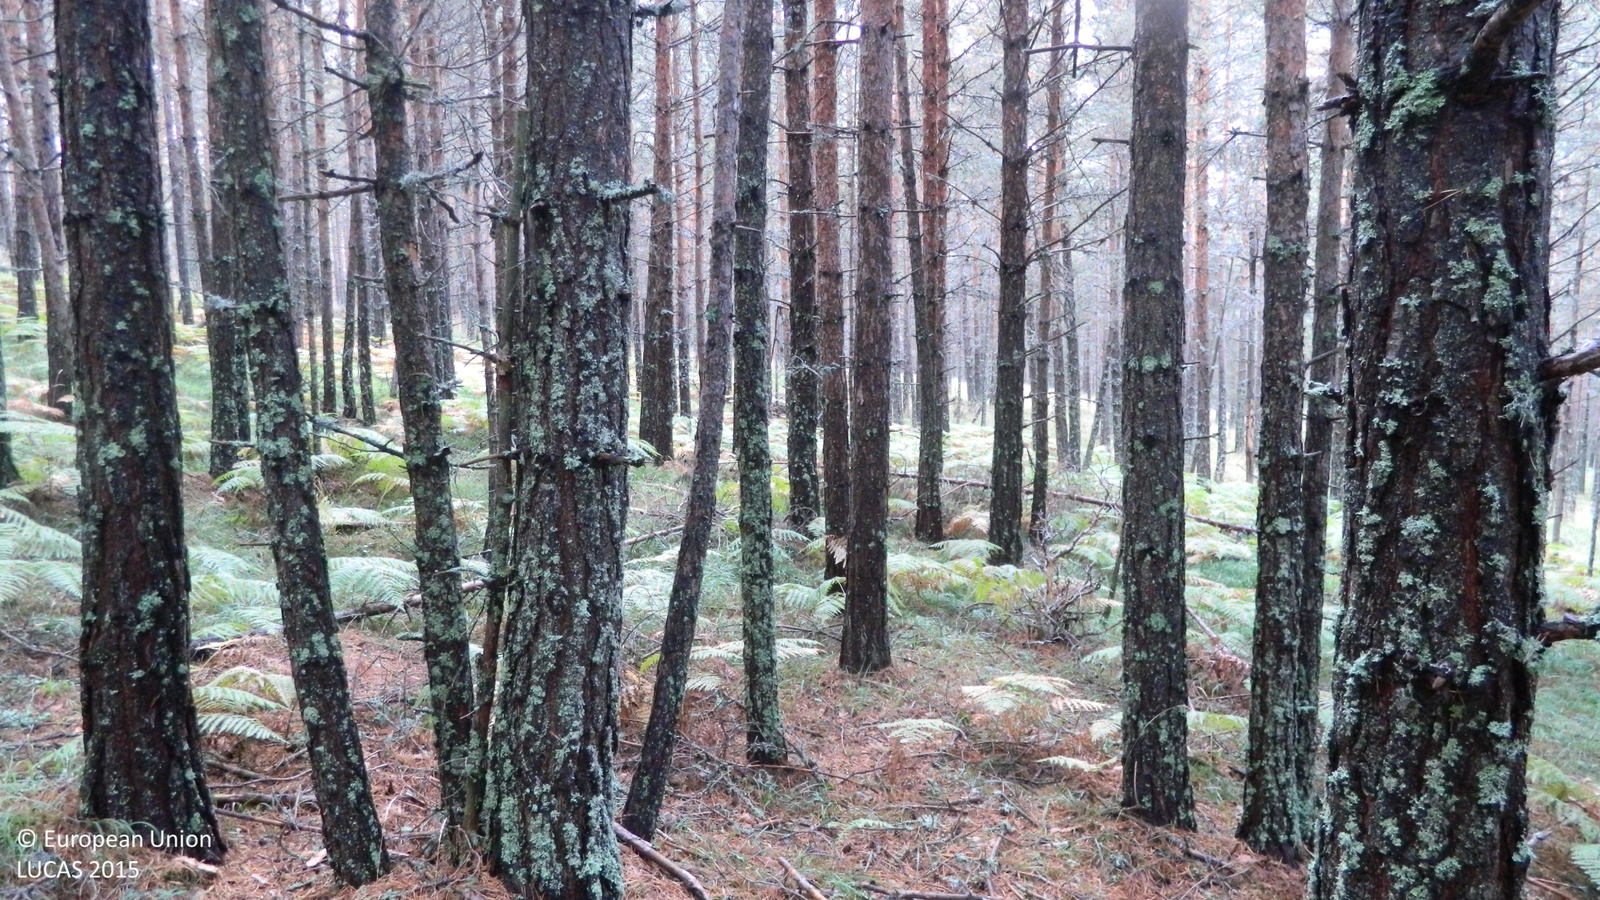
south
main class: Woodland
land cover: Pine dominated coniferous woodland
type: hemiboreal forest and nemoral coniferous forest and mixed broadleaved-coniferous forest
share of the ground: > 75 %
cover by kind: coniferous forest trees 95 %, herbaceous plants 5 %
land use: Forestry
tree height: > 5 m
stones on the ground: < 10 %
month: September
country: BG
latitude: 41.6480
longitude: 24.0702
